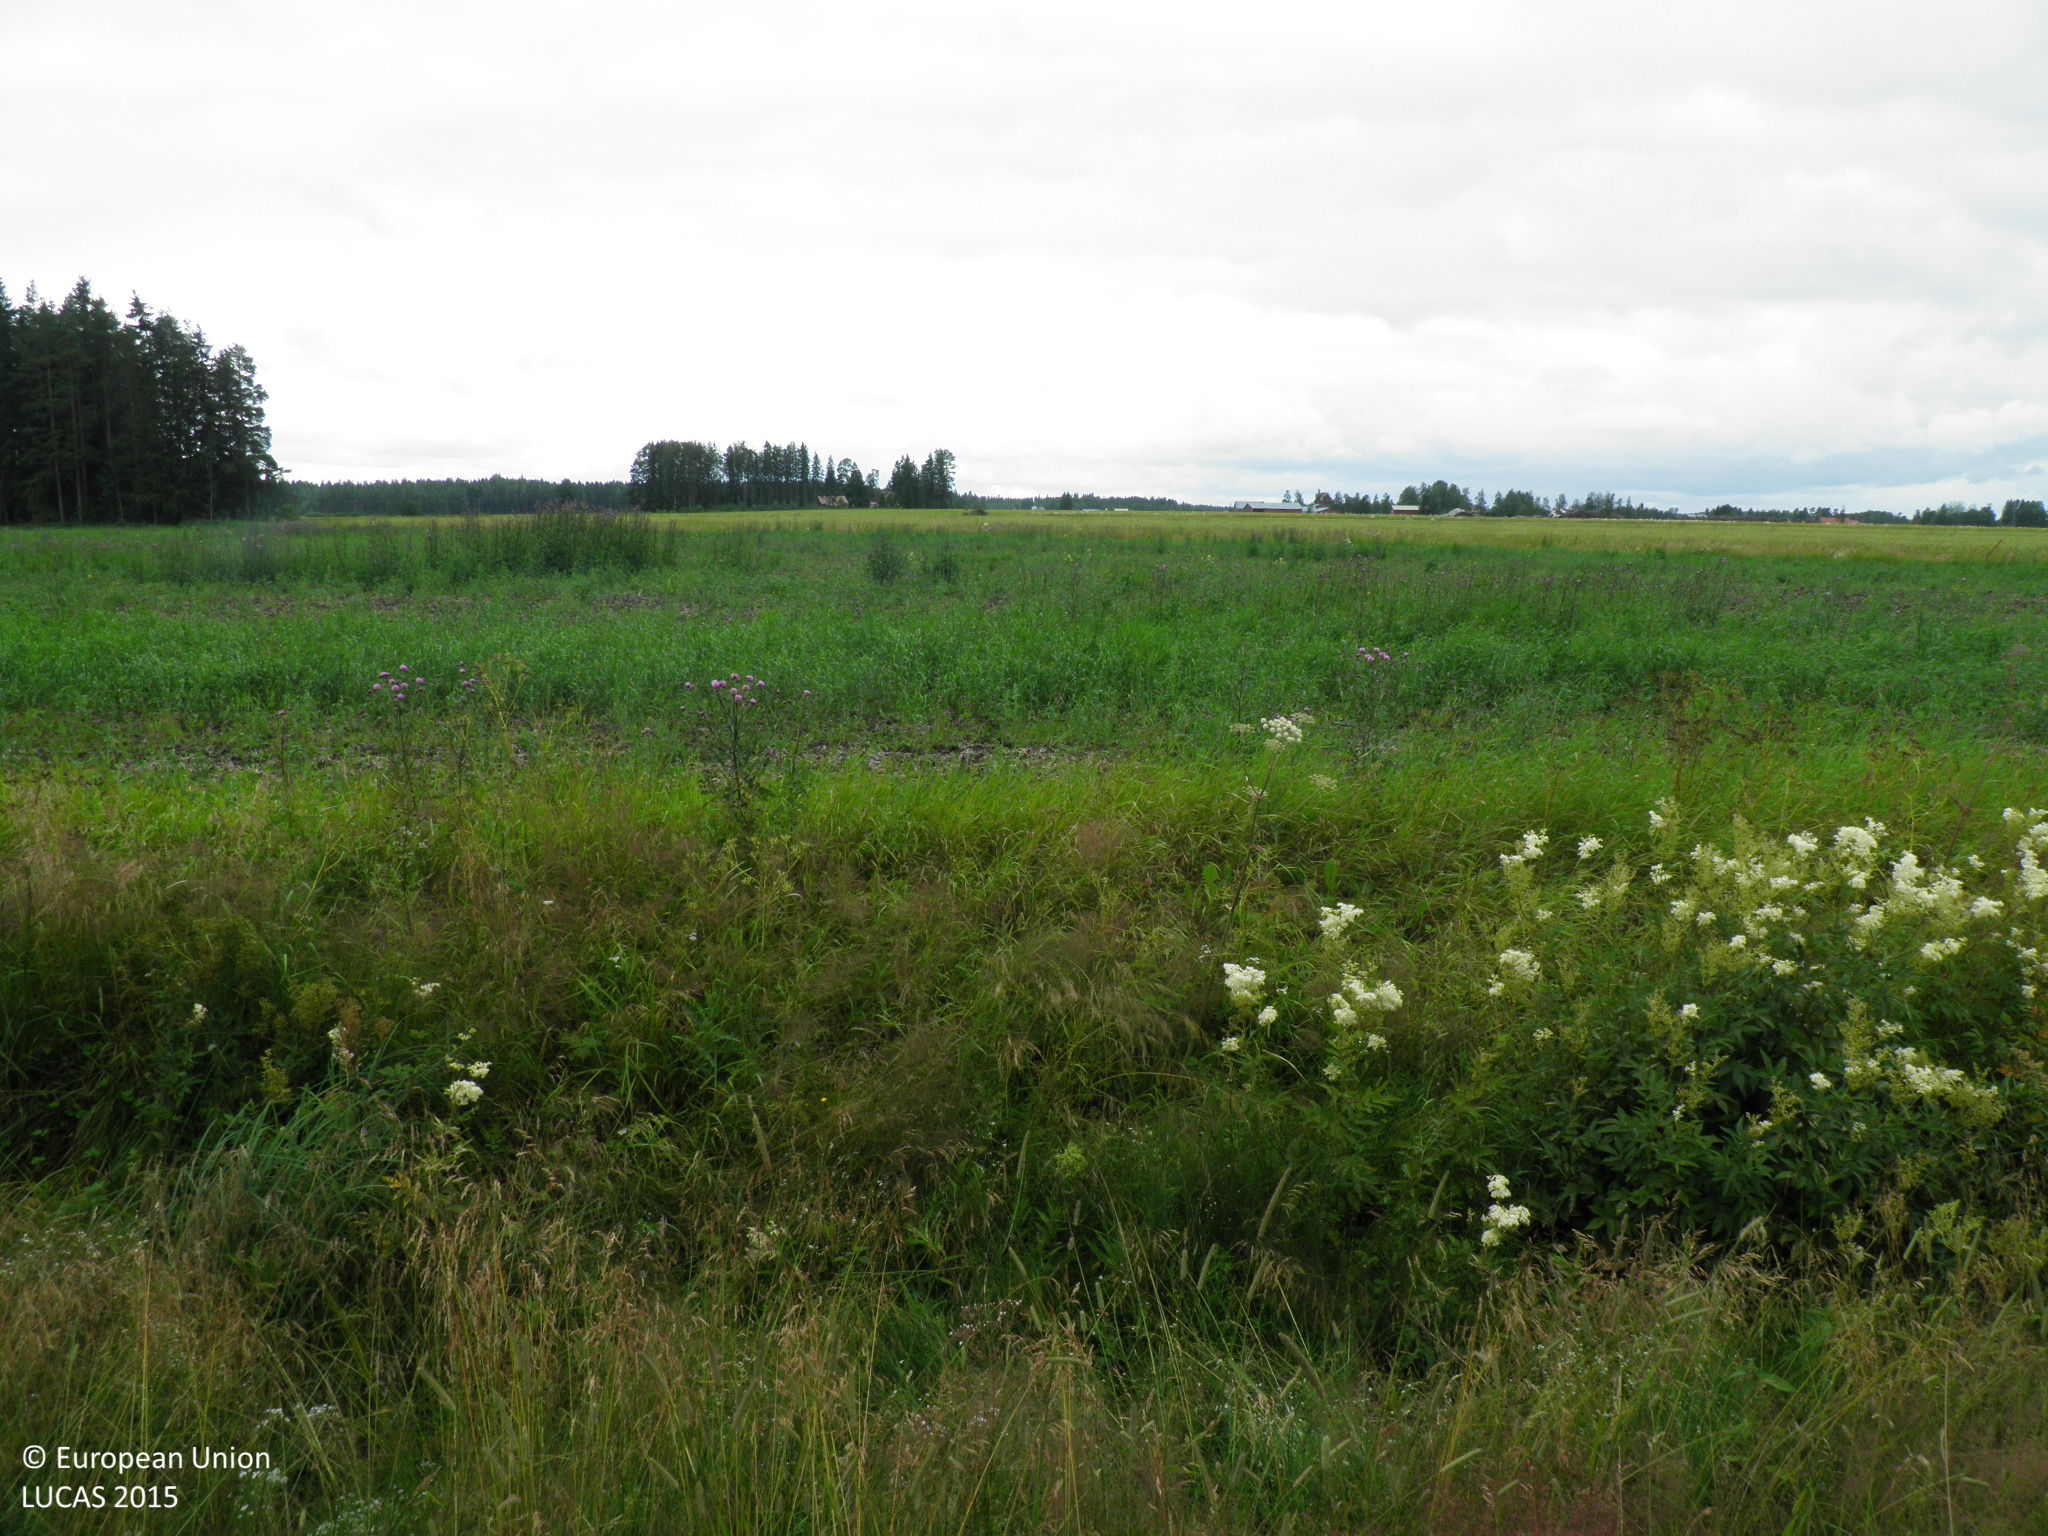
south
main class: Cropland
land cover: Common wheat
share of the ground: > 75 %
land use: Agriculture (excluding fallow land and kitchen gardens)
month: July
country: FI
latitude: 60.9028
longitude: 22.8855
